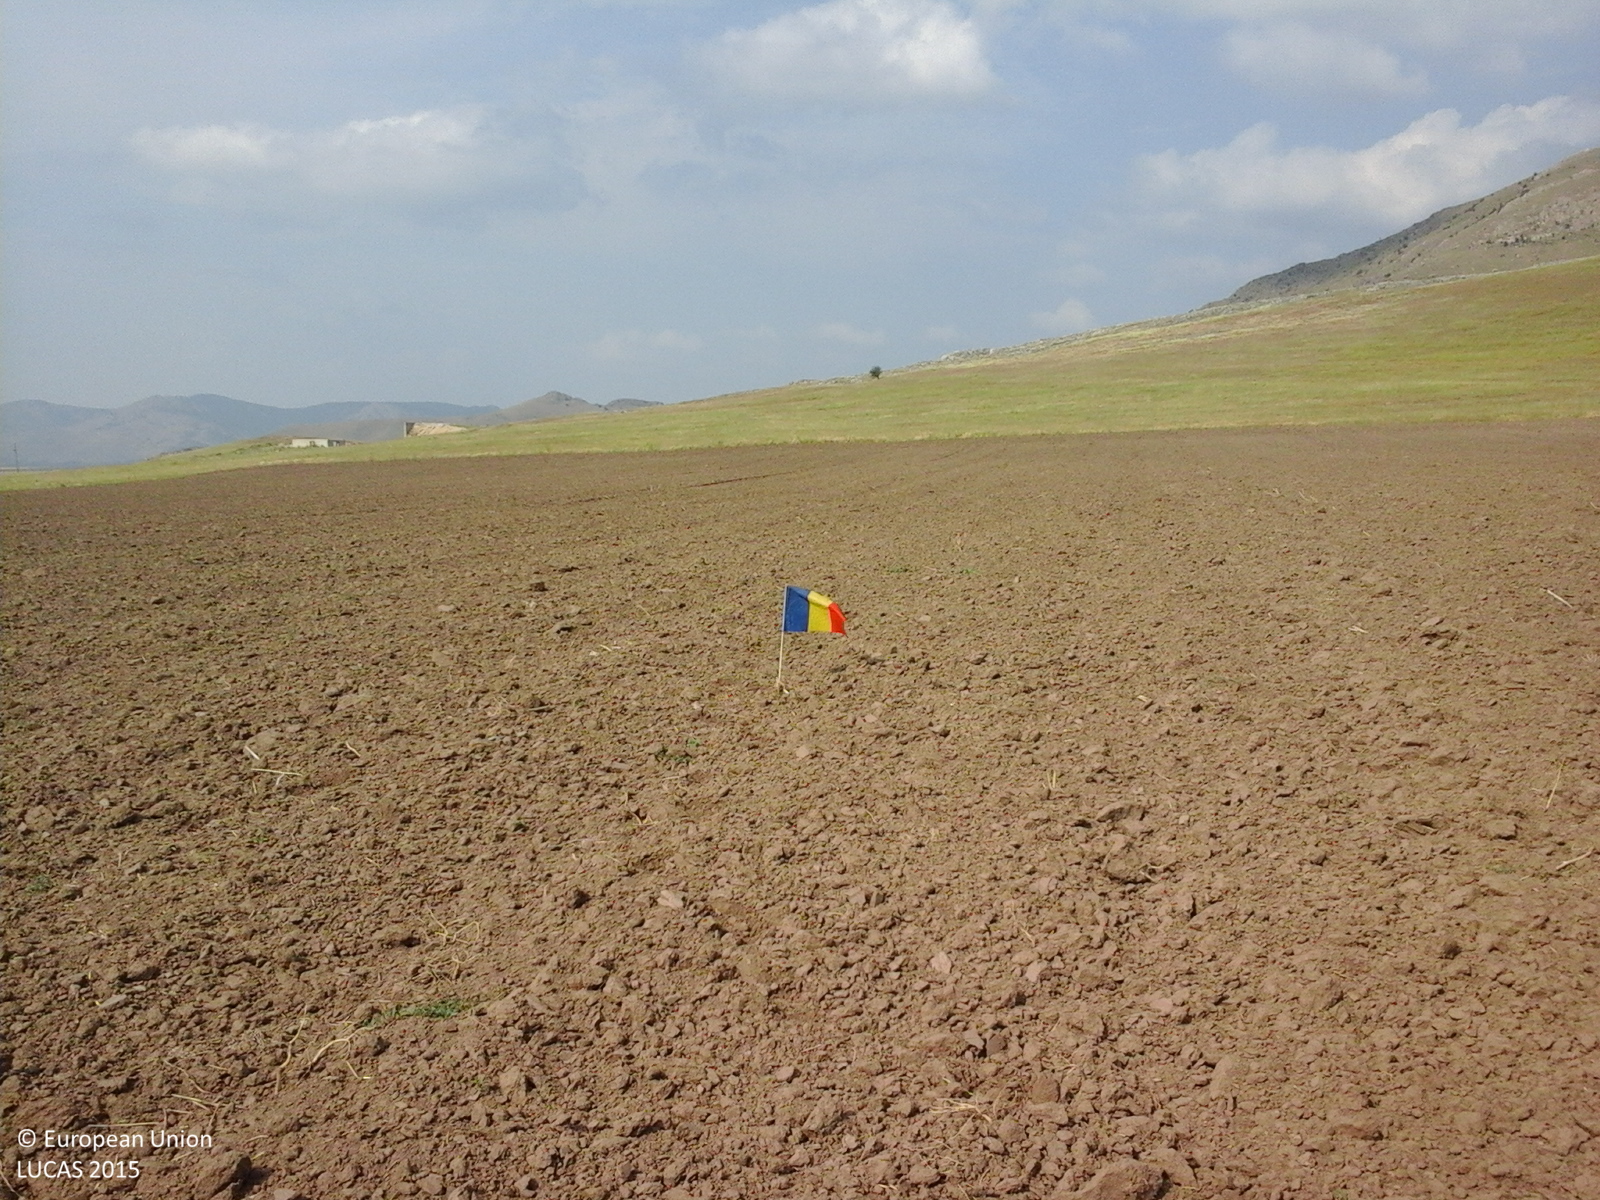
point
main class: Cropland
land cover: Rape and turnip rape
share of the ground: < 10 %
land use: Agriculture (excluding fallow land and kitchen gardens)
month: July
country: RO
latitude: 45.1168
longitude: 28.2356
